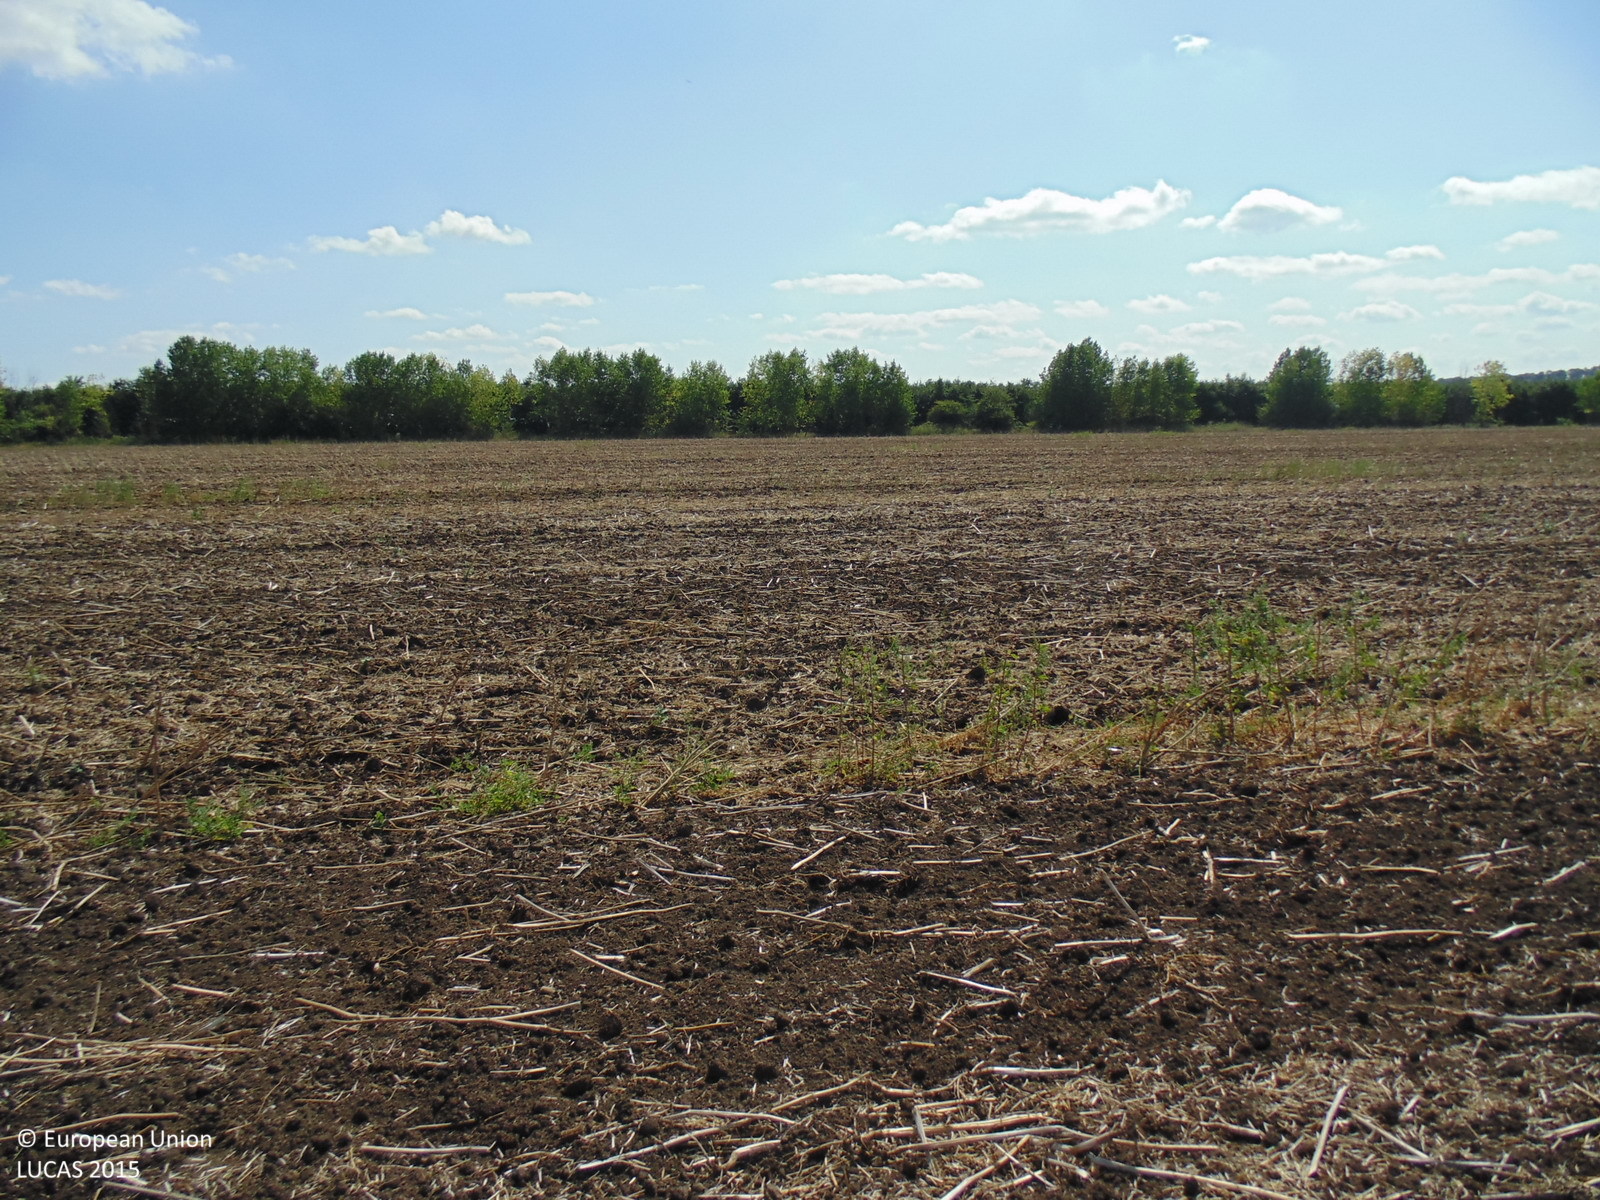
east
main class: Cropland
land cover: Rape and turnip rape
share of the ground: < 10 %
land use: Agriculture (excluding fallow land and kitchen gardens)
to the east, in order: Rape and turnip rape; Grass margins; Tracks; Grass margins; Broadleaved woodland; Grass margins; Sunflower
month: August
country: BG
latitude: 43.6789
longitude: 28.1253
